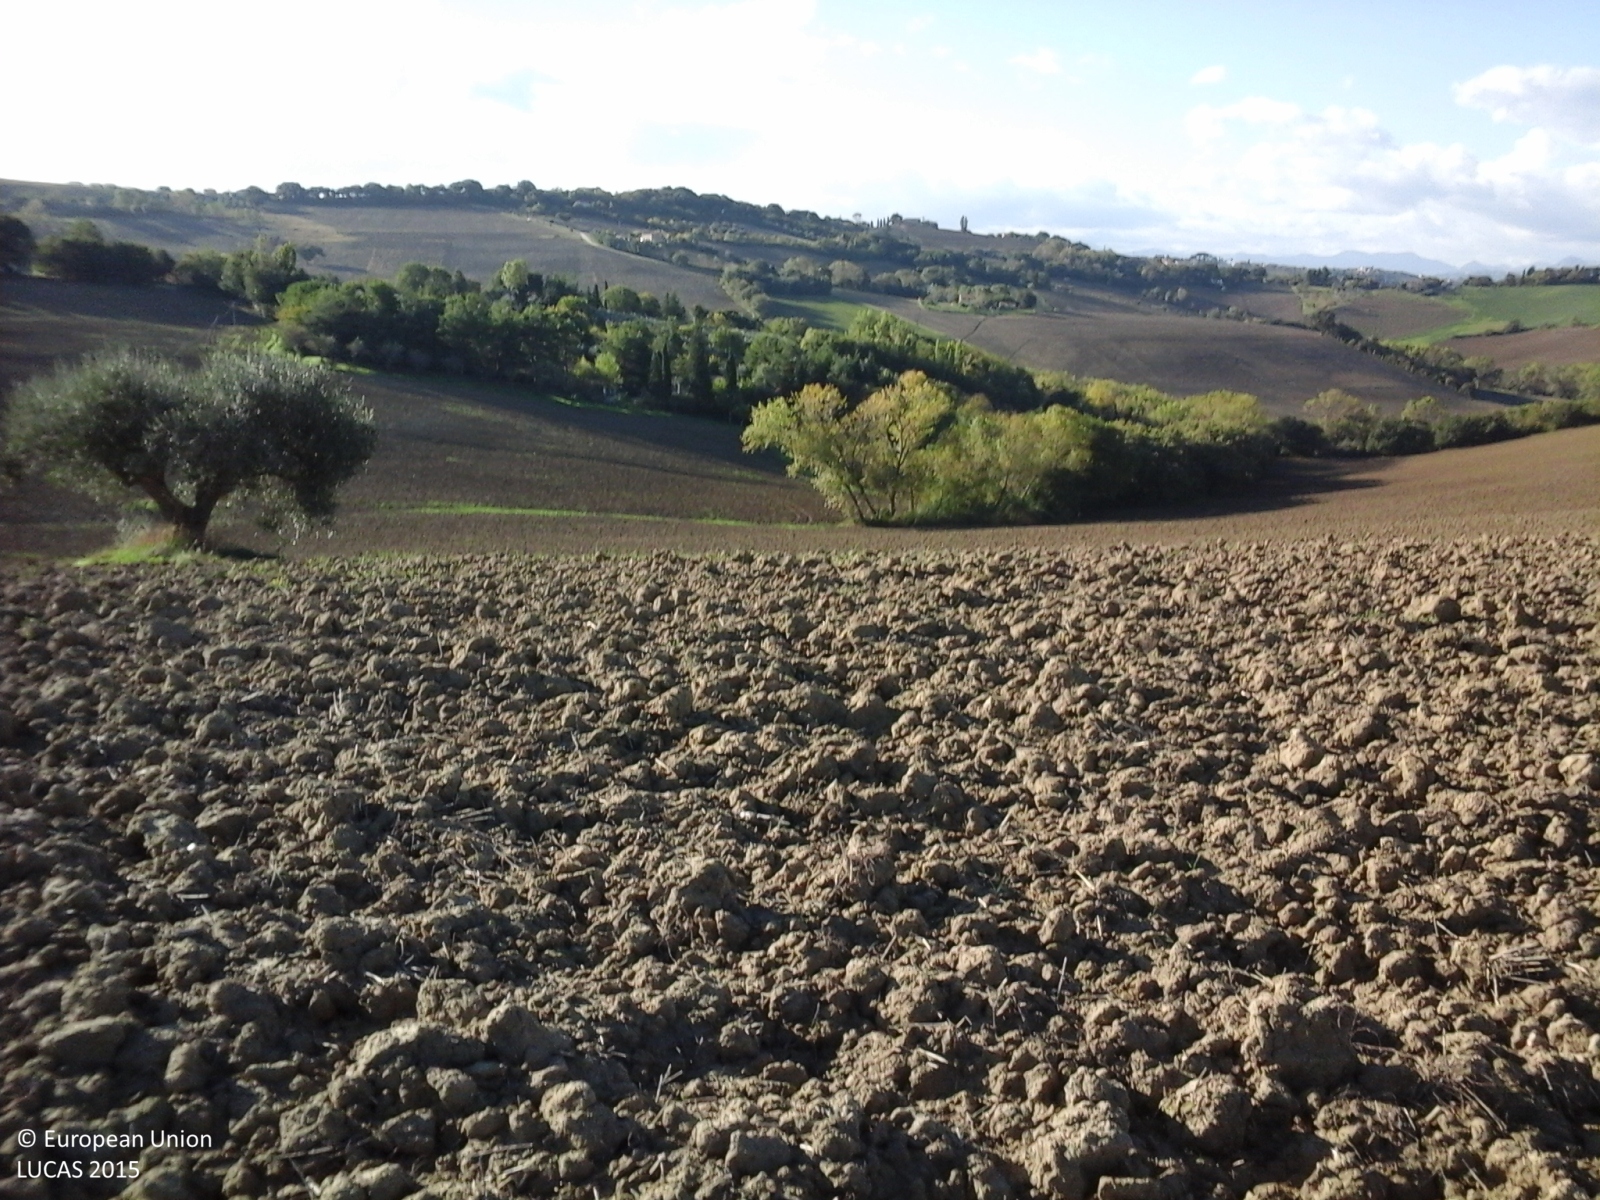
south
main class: Cropland
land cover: Durum wheat
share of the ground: < 10 %
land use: Agriculture (excluding fallow land and kitchen gardens)
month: October
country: IT
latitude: 43.6520
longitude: 13.1788
